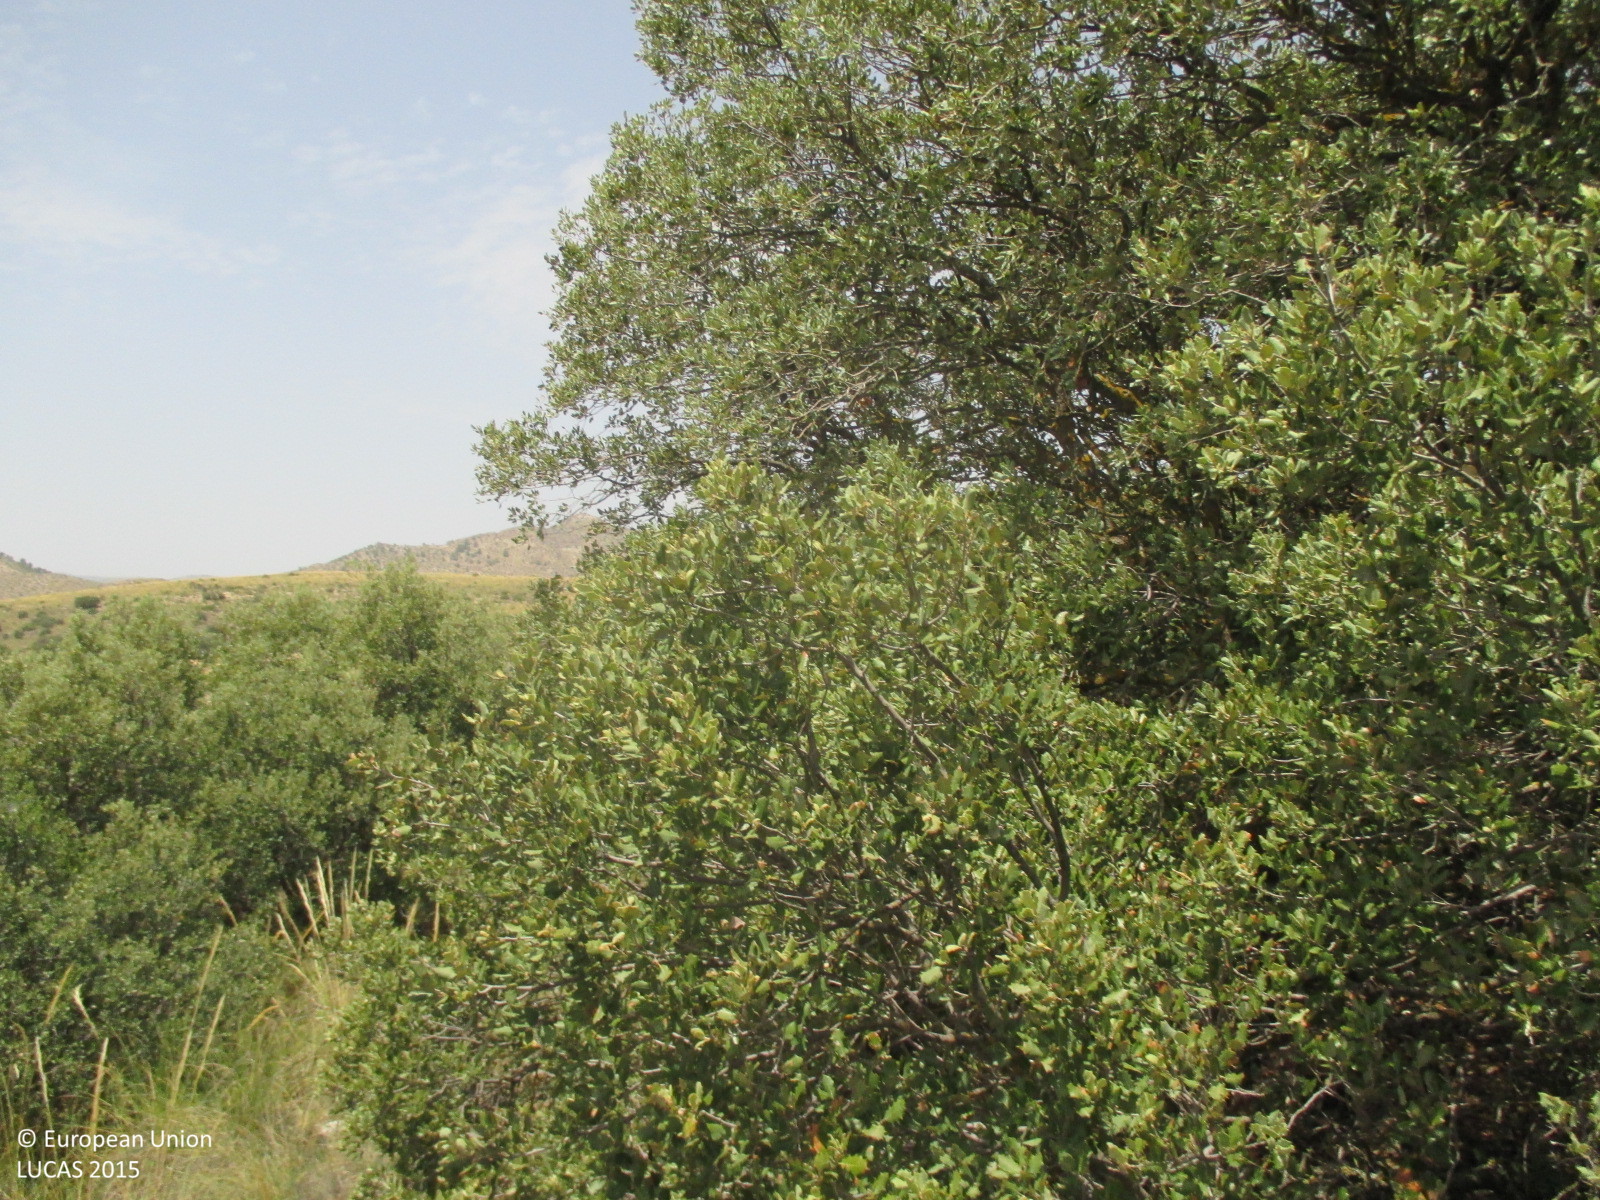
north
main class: Woodland
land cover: Broadleaved woodland
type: broadleaved evergreen forest
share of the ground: 50 - 75 %
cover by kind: broadleaved forest trees 50 %, herbaceous plants 40 %, shrubs 10 %
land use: Semi-natural and natural areas not in use
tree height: < 5 m
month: July
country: ES
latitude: 37.9247
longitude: -2.3791
